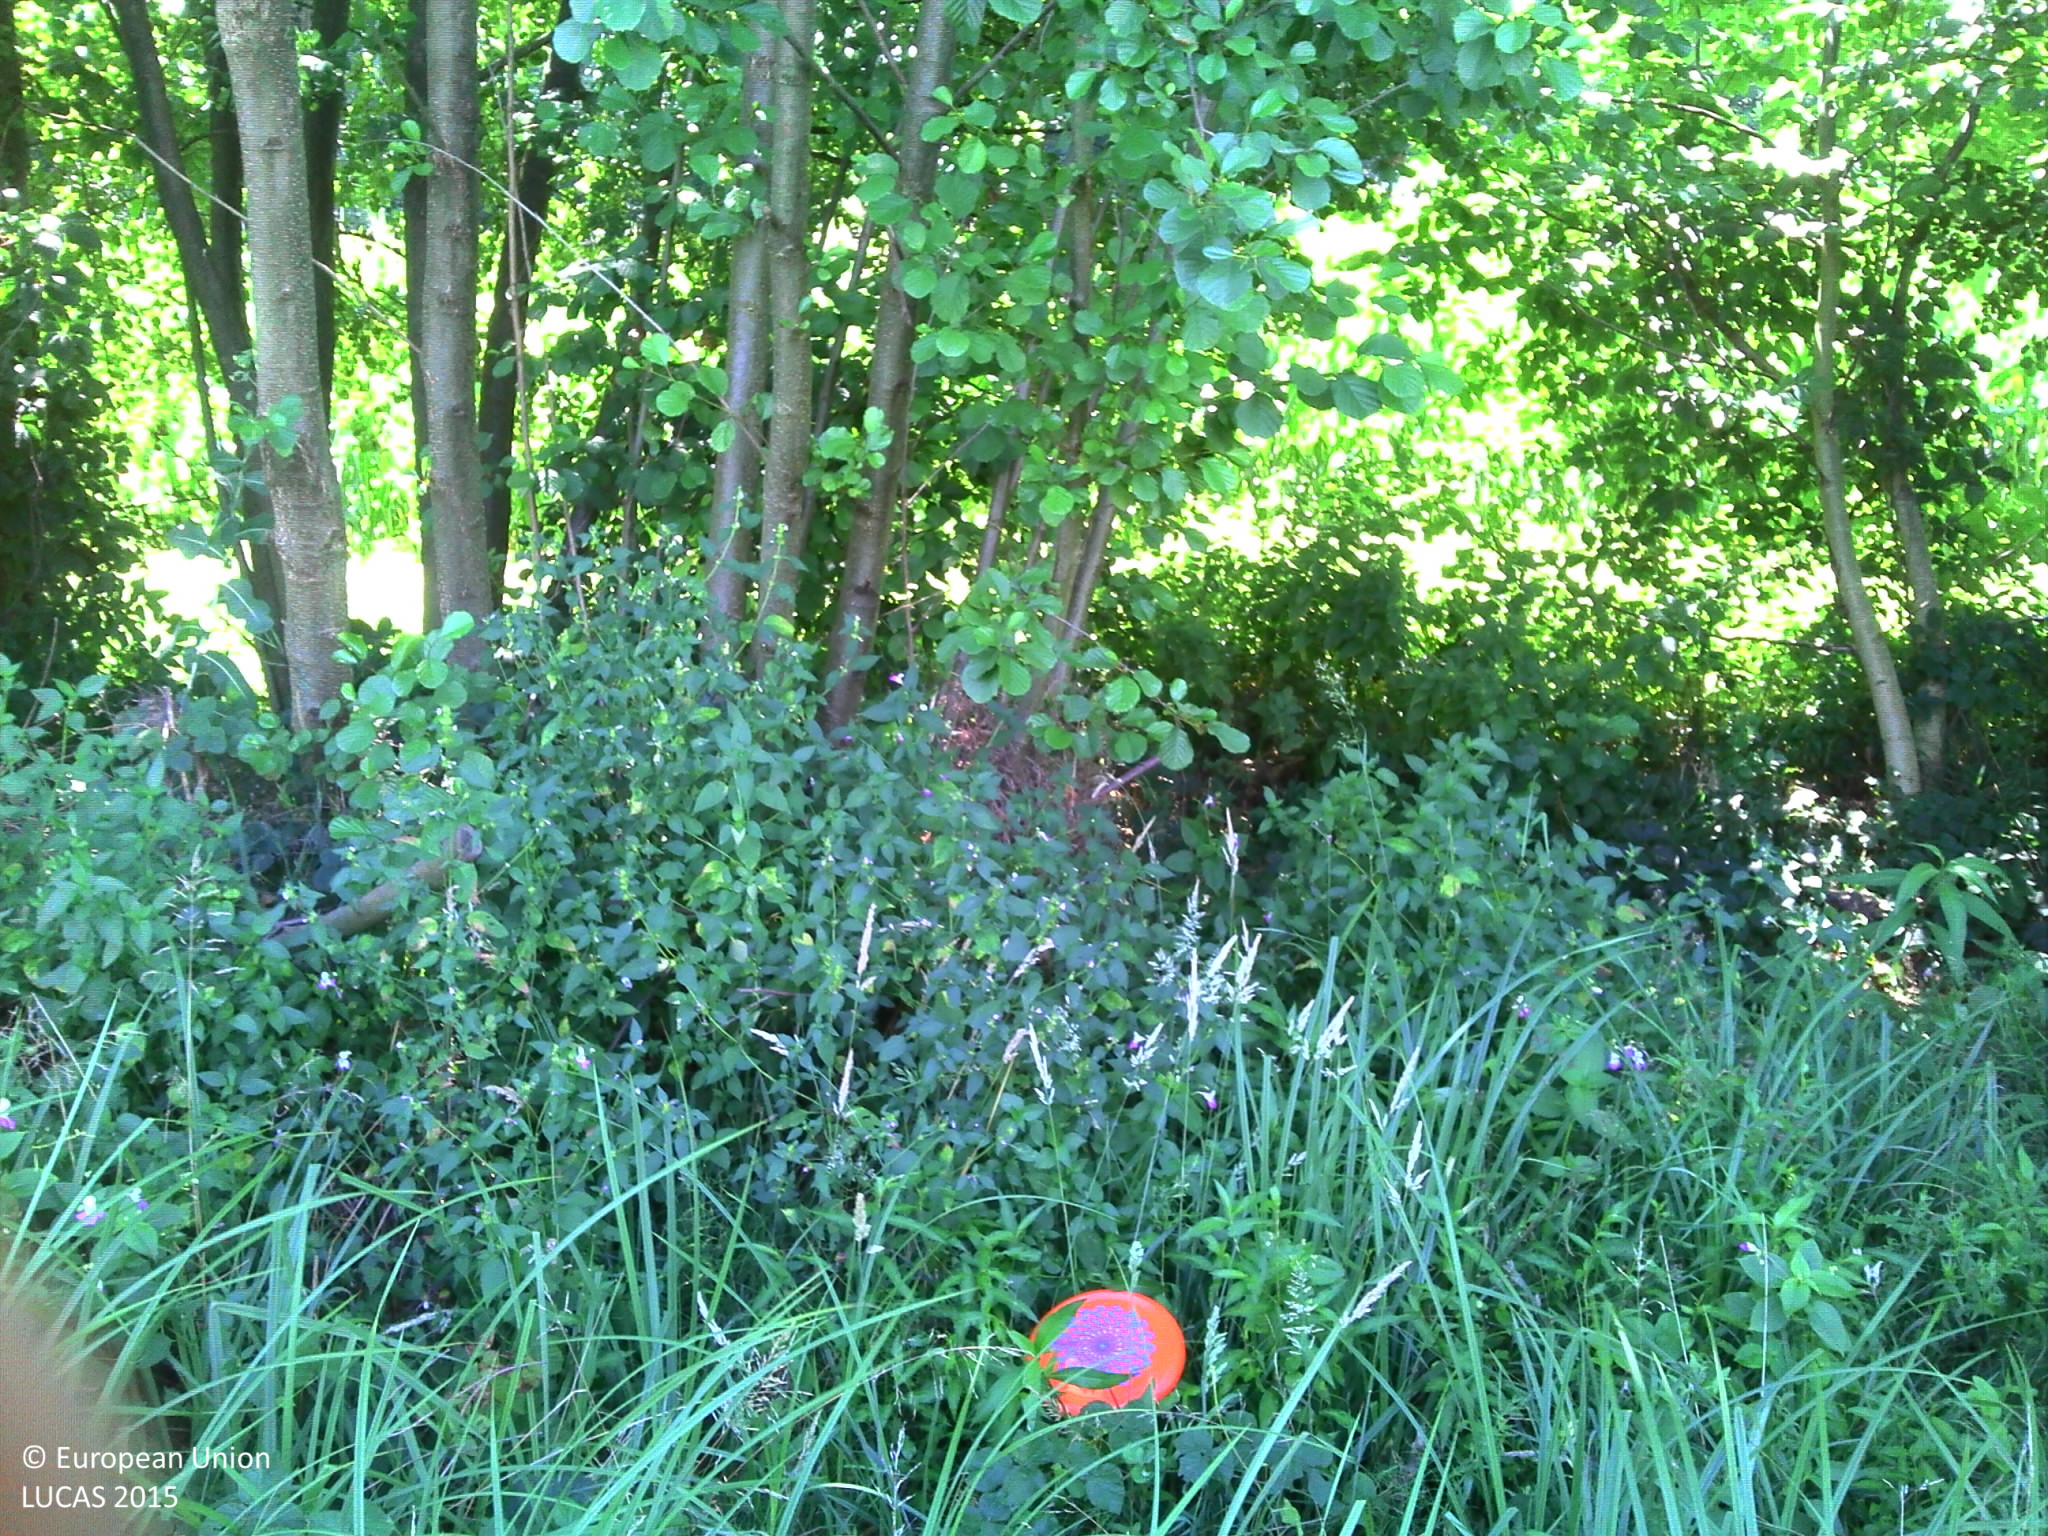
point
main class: Woodland
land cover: Broadleaved woodland
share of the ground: > 75 %
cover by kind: broadleaved forest trees 80 %, herbaceous plants 20 %
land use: Semi-natural and natural areas not in use
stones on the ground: < 10 %
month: July
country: FR
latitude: 45.3265
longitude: 4.8885
